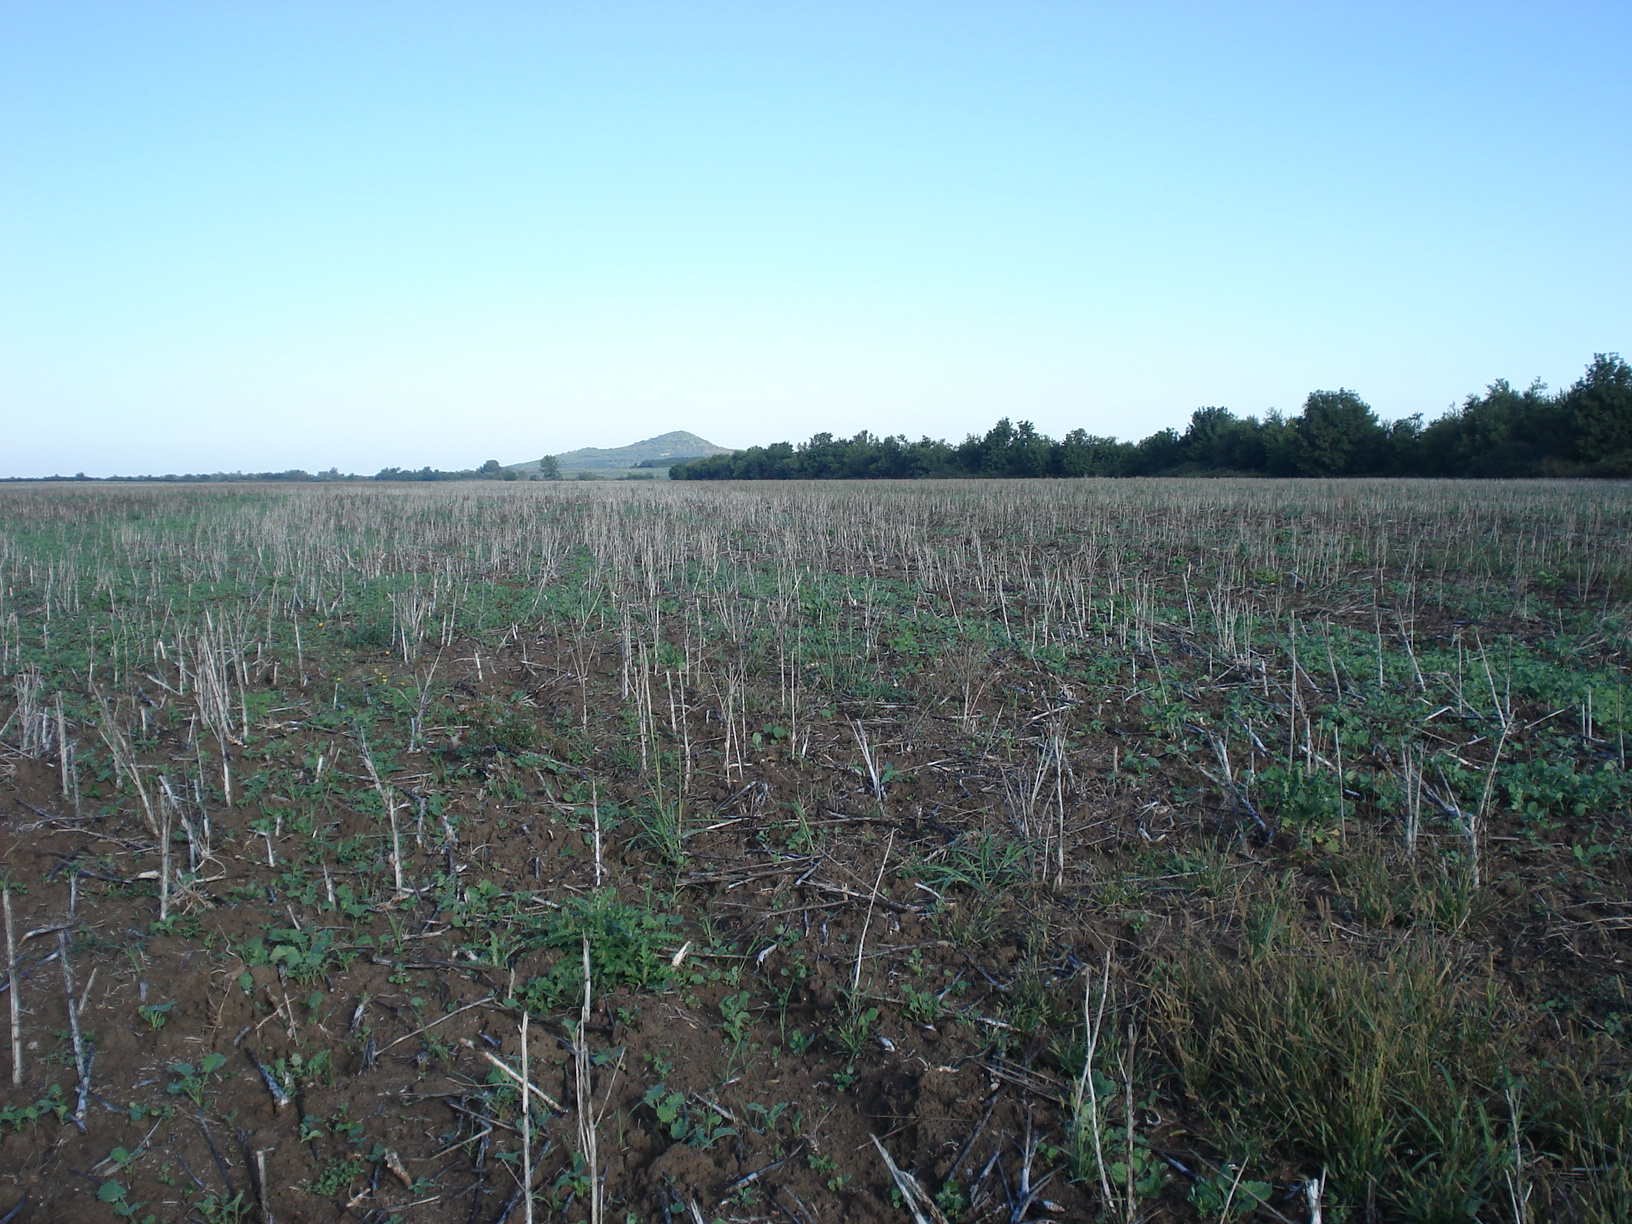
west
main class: Grassland
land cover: Spontaneously vegetated surfaces
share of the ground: > 75 %
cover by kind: herbaceous plants 80 %, unconsolidated bare surface 20 %
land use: Agriculture (excluding fallow land and kitchen gardens)
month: September
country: BG
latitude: 43.2505
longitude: 25.2605
